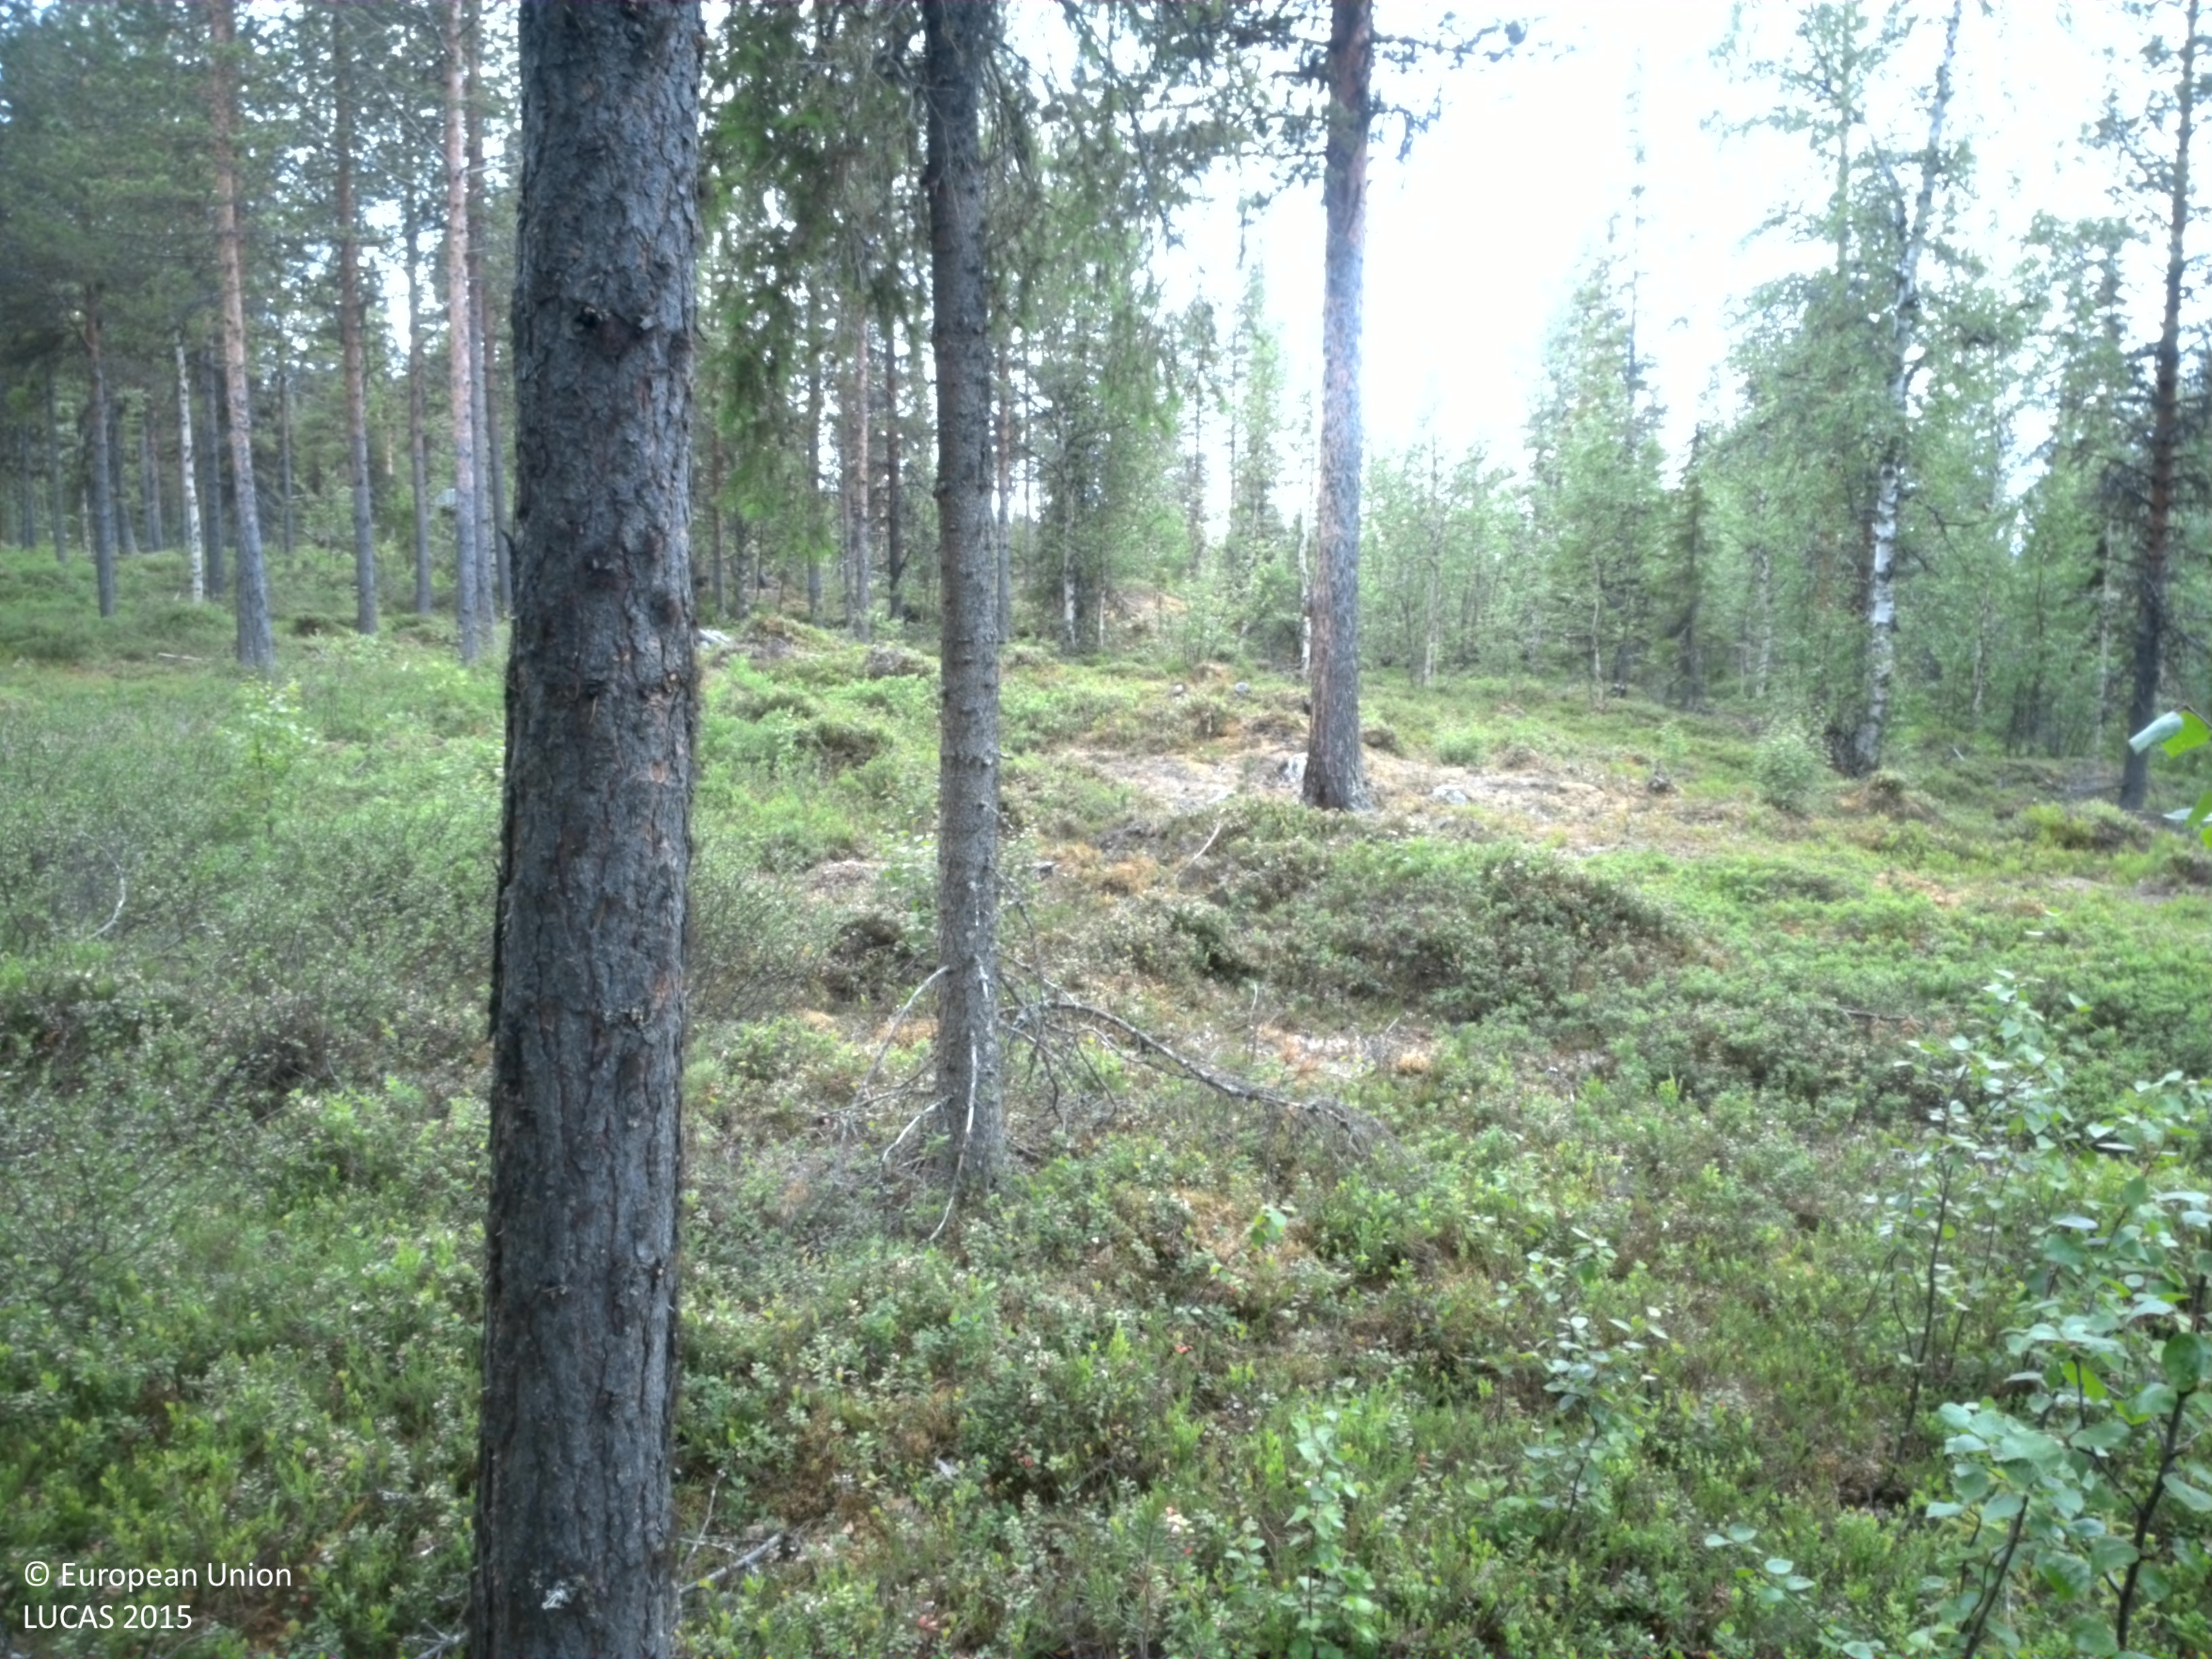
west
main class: Woodland
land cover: Pine dominated mixed woodland
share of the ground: 10 - 25 %
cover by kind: shrubs 75 %, broadleaved forest trees 15 %, coniferous forest trees 10 %
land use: Forestry
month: July
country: SE
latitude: 66.9087
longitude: 18.3328
